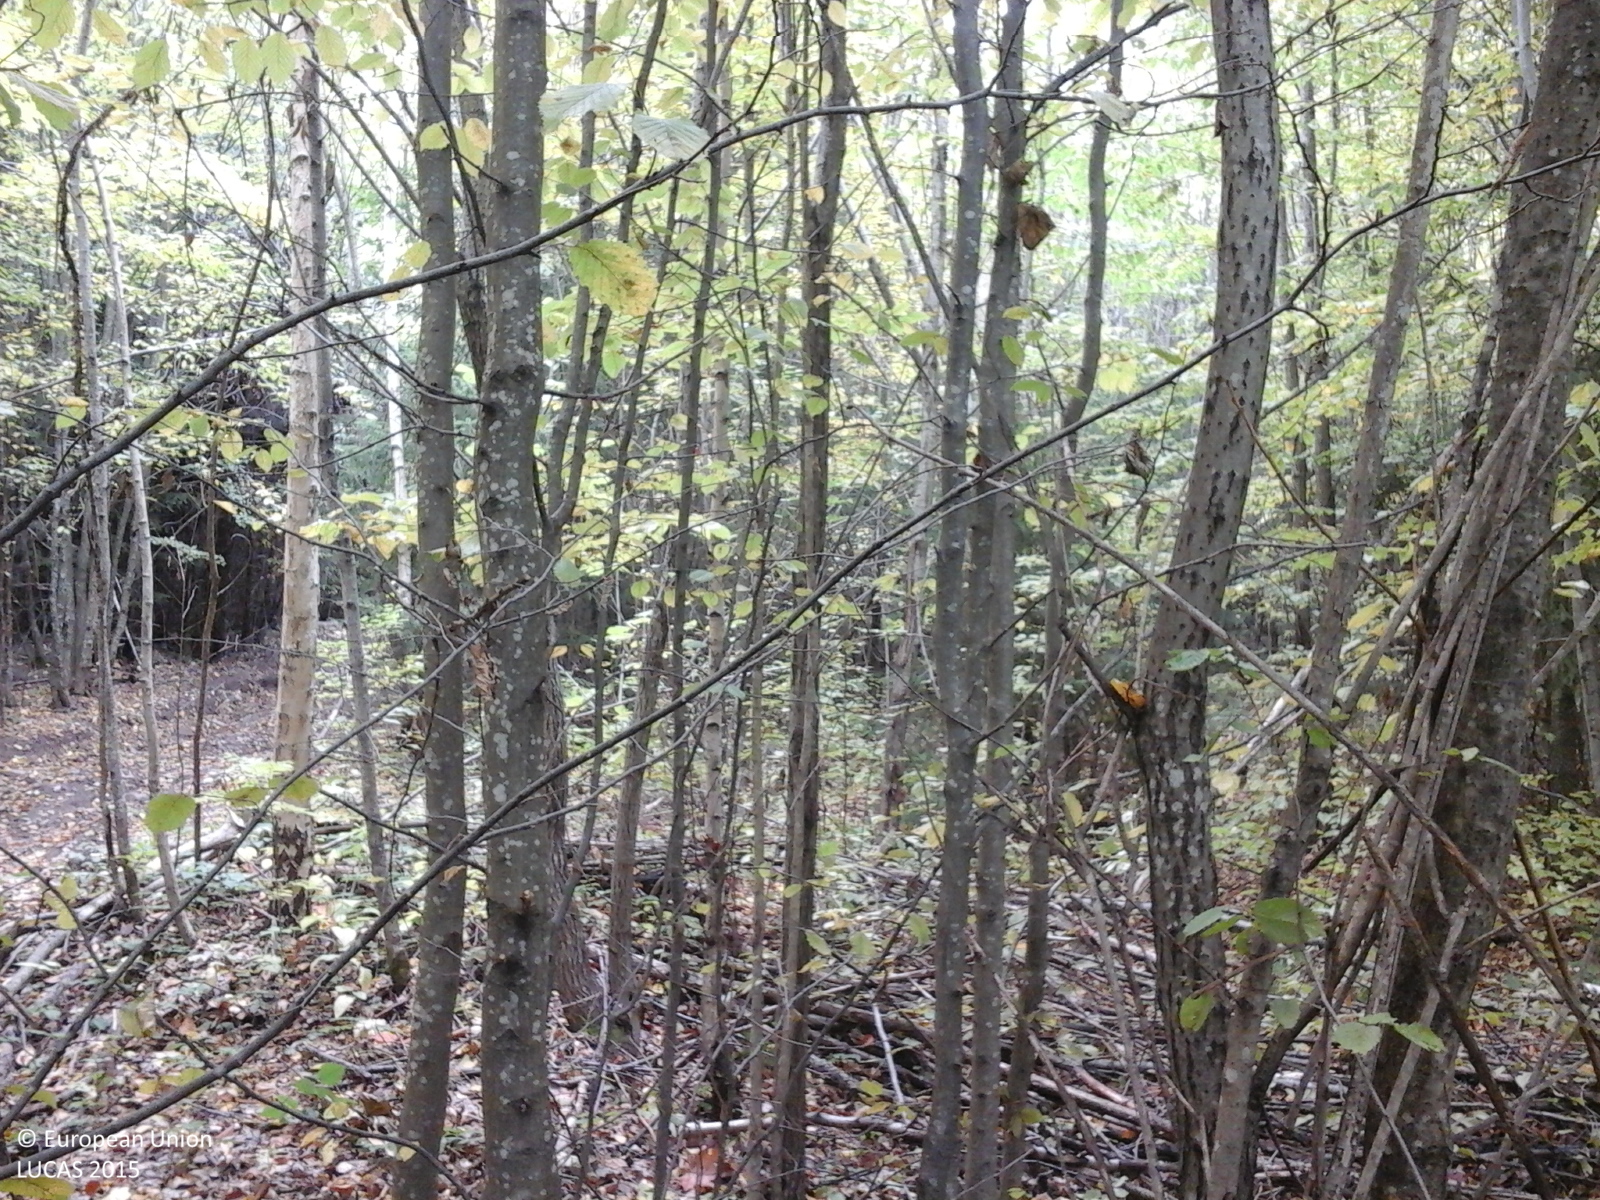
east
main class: Woodland
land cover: Broadleaved woodland
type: beech forest
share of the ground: > 75 %
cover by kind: broadleaved forest trees 100 %
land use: Forestry
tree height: > 5 m
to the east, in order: Broadleaved woodland; Tracks; Broadleaved woodland
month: October
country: RO
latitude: 46.4609
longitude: 25.4859
